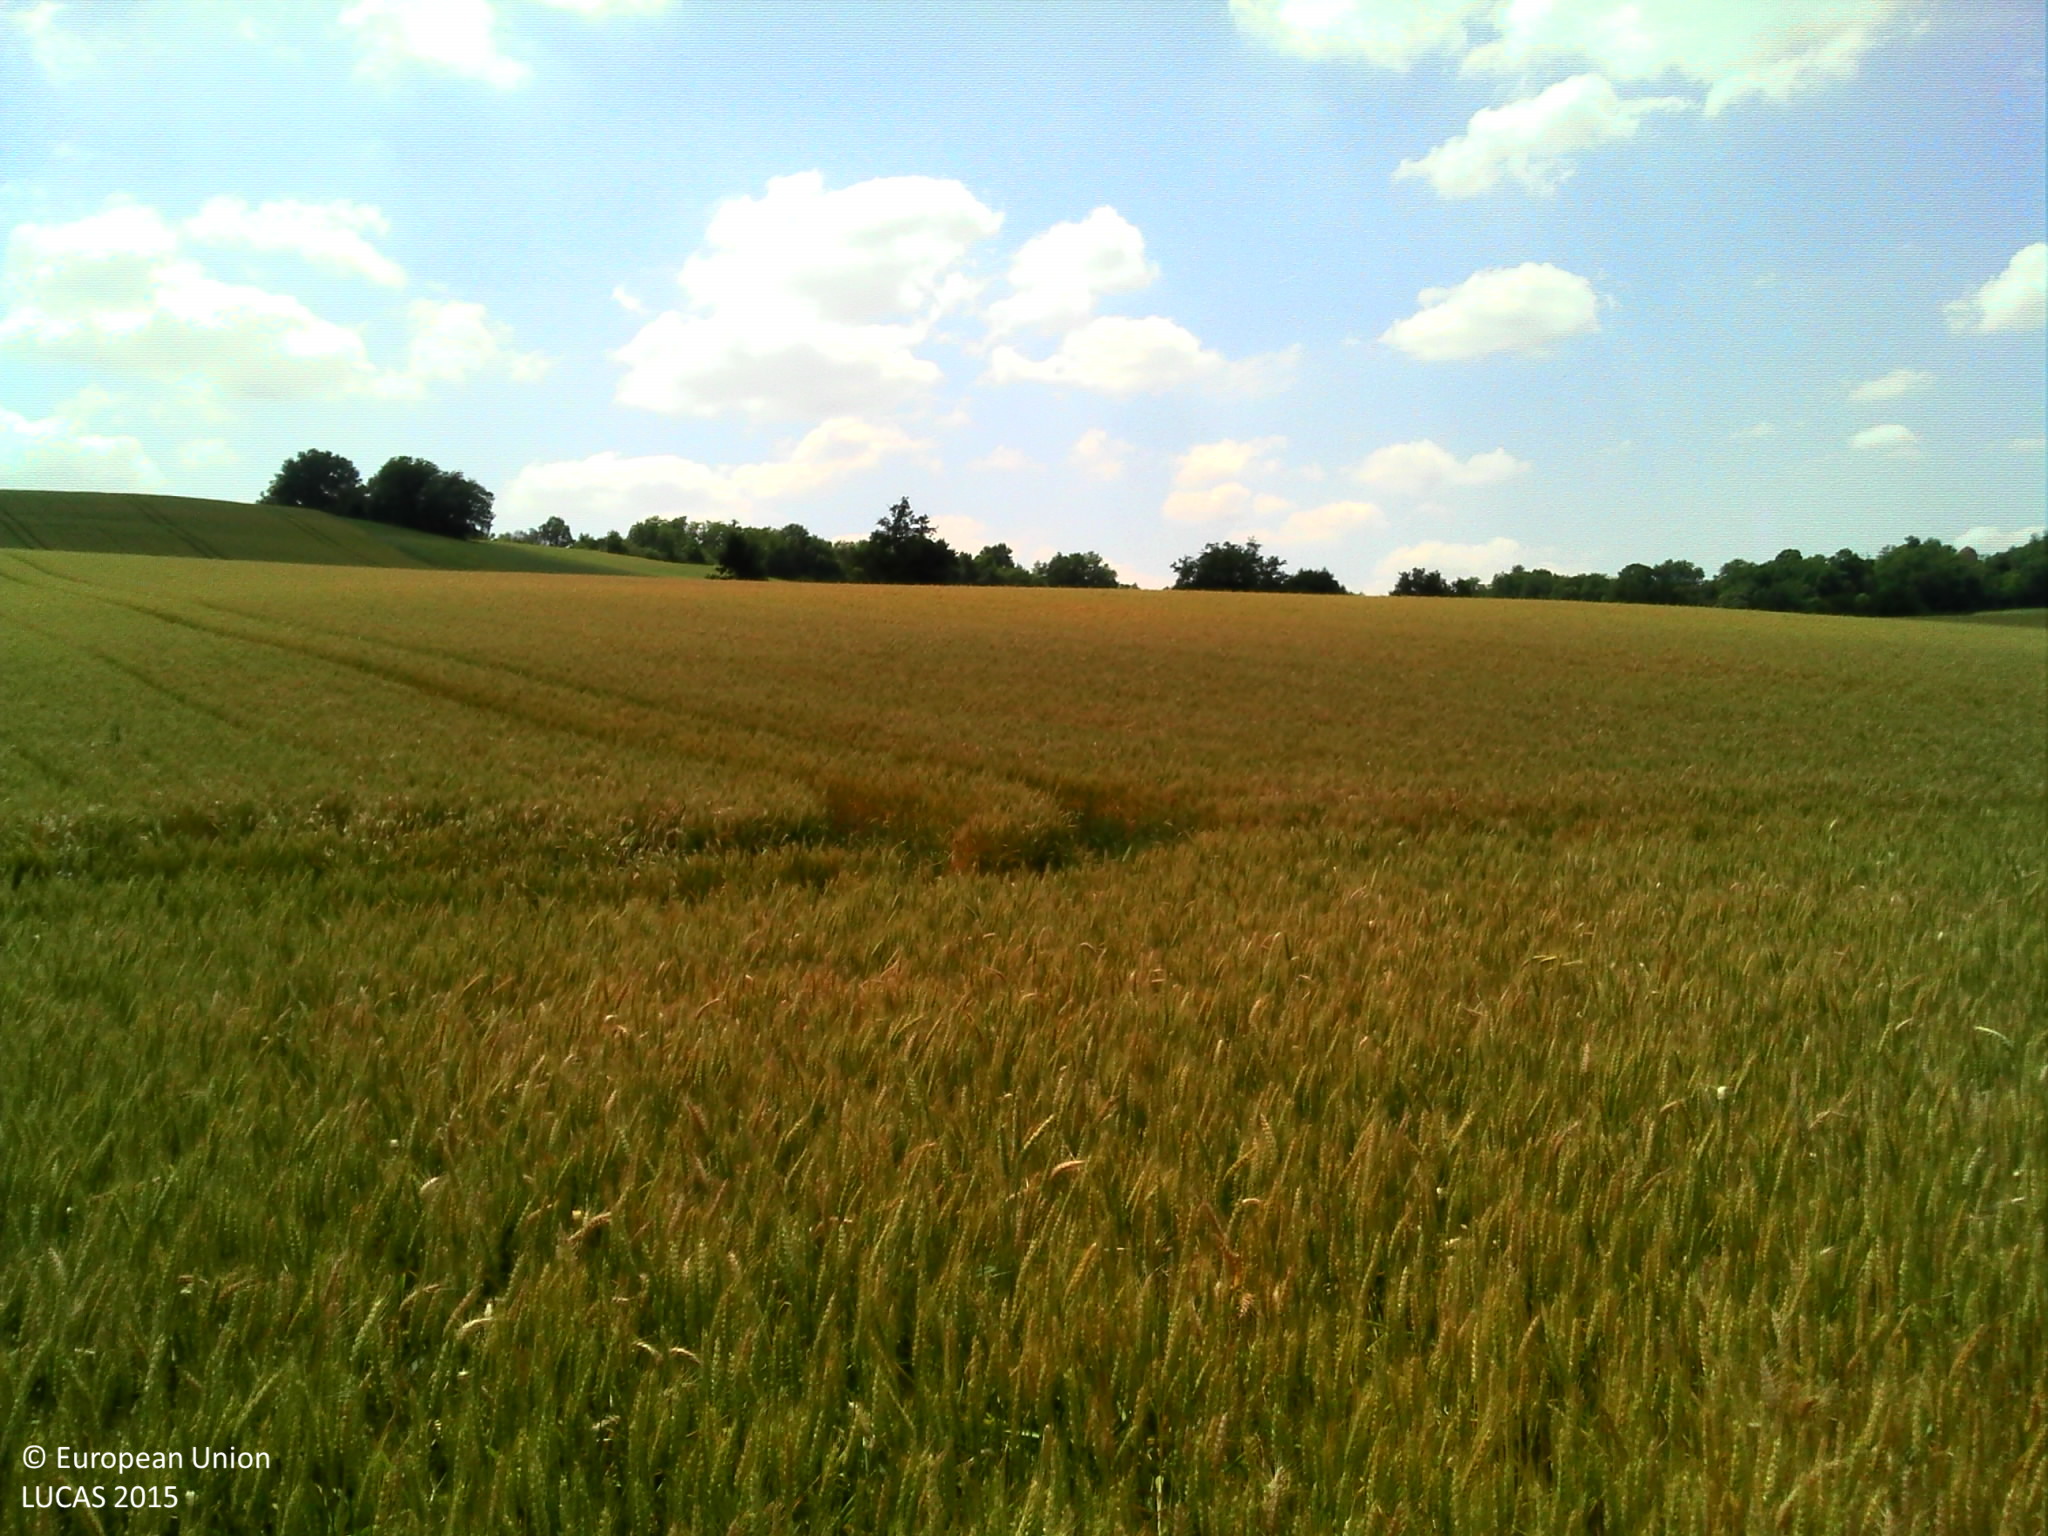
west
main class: Grassland
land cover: Grassland without tree/shrub cover
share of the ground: > 75 %
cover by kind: herbaceous plants 100 %
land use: Agriculture (excluding fallow land and kitchen gardens)
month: June
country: FR
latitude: 43.7547
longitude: 0.7453
